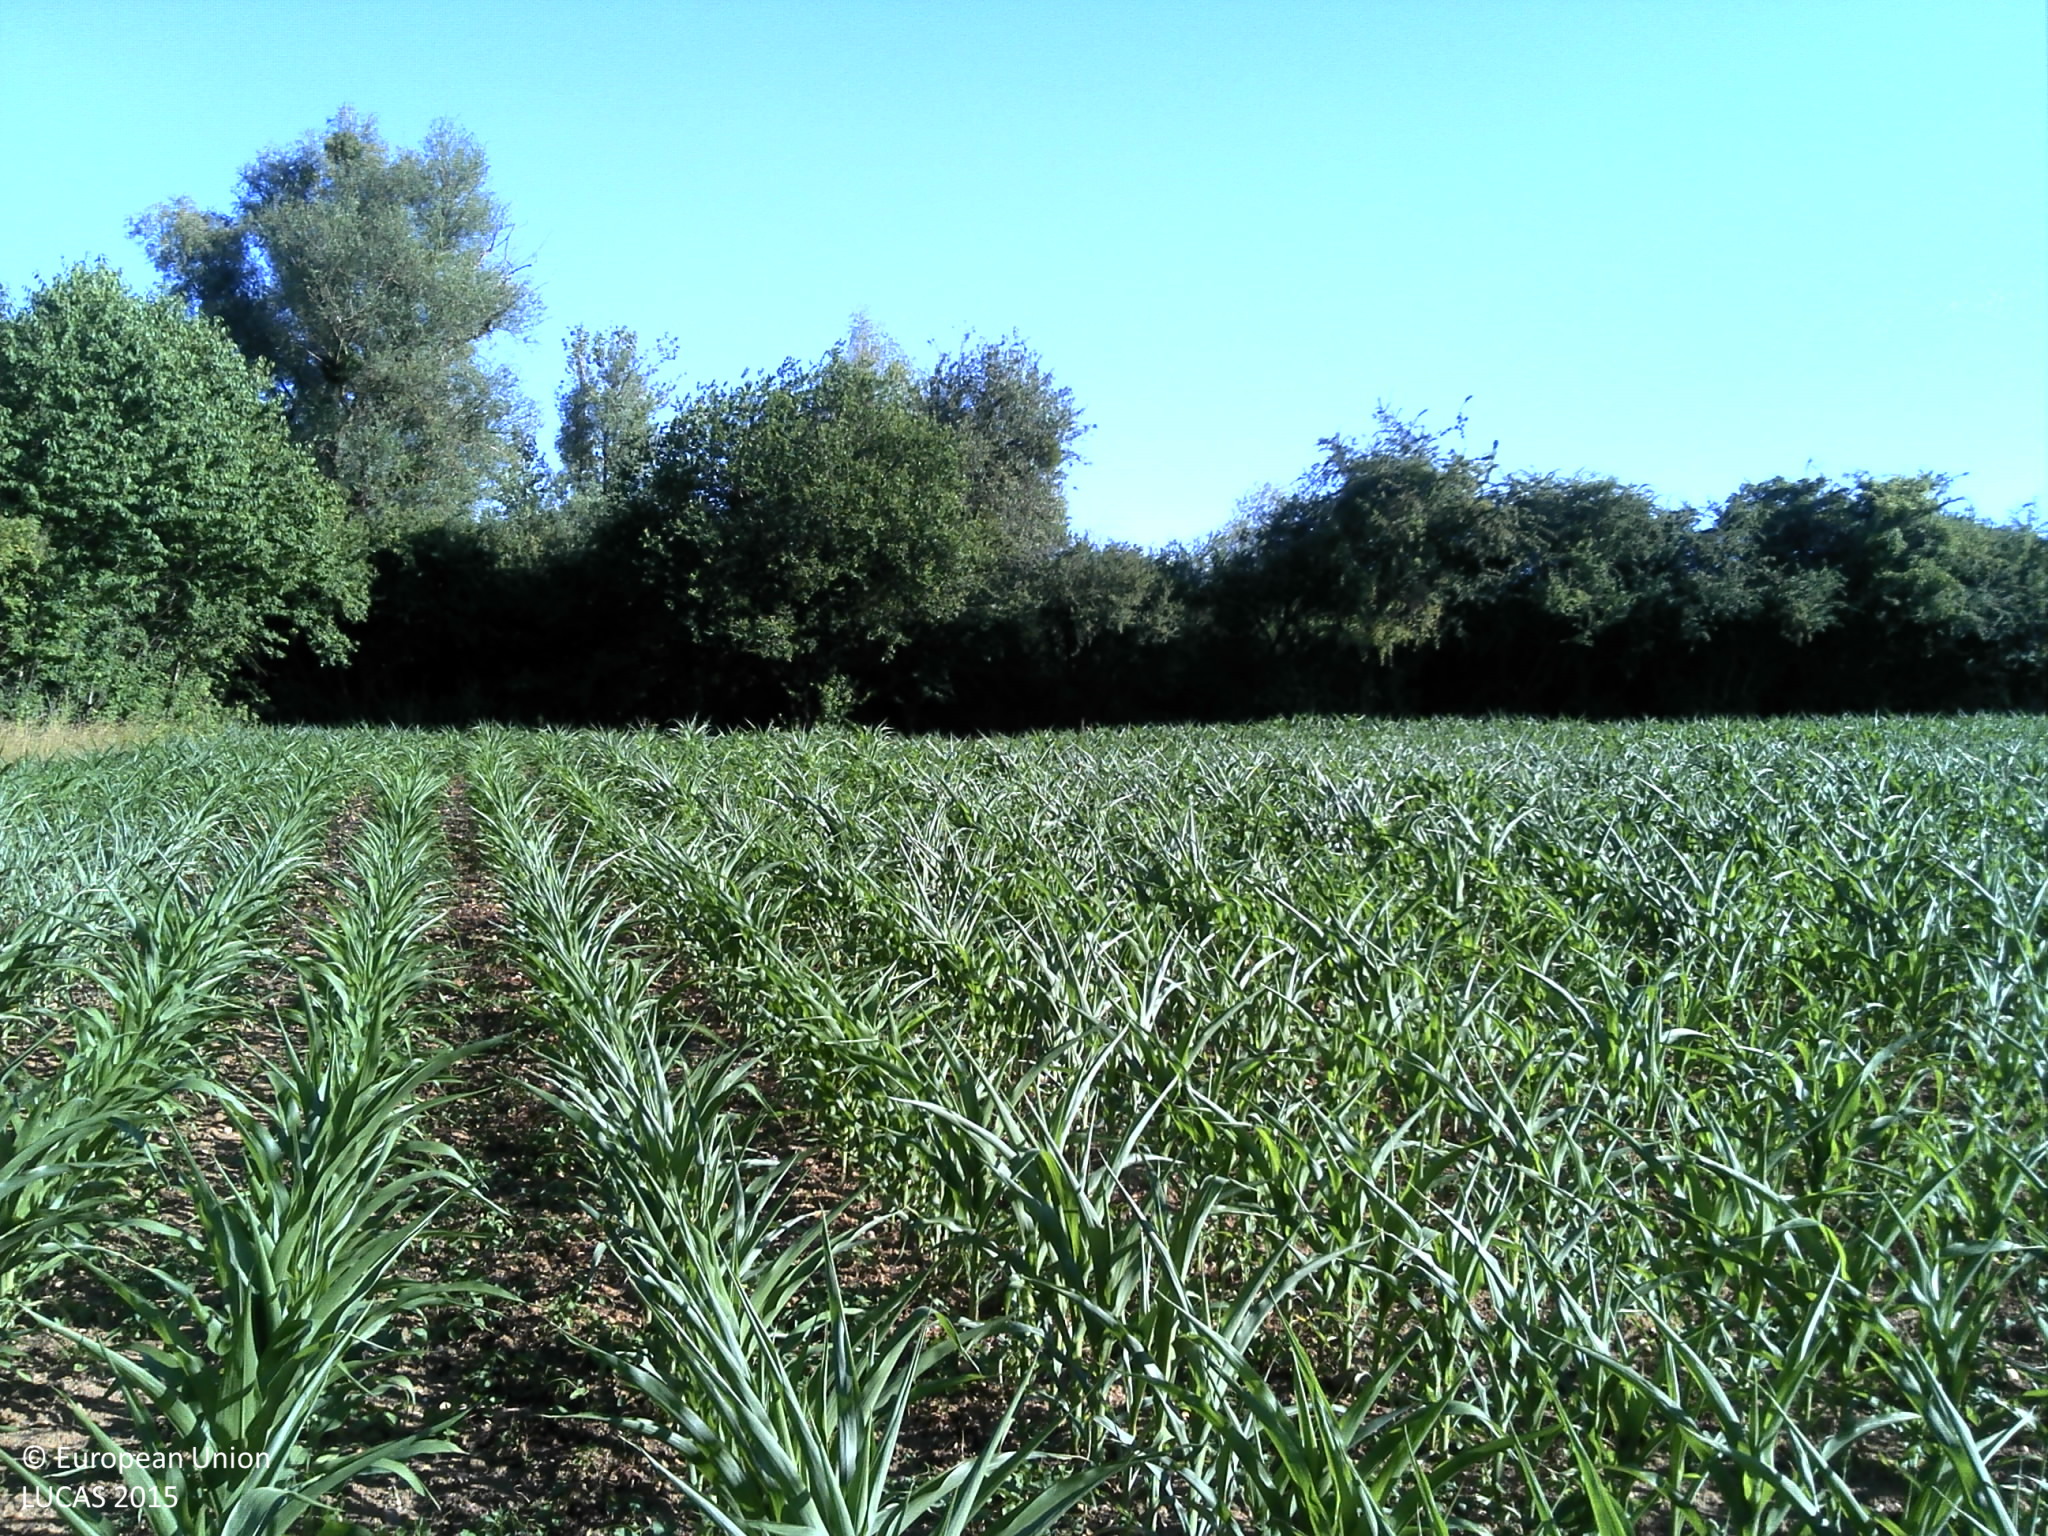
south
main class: Cropland
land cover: Maize
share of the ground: 25 - 50 %
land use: Agriculture (excluding fallow land and kitchen gardens)
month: June
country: FR
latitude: 49.3822
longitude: 6.1839
